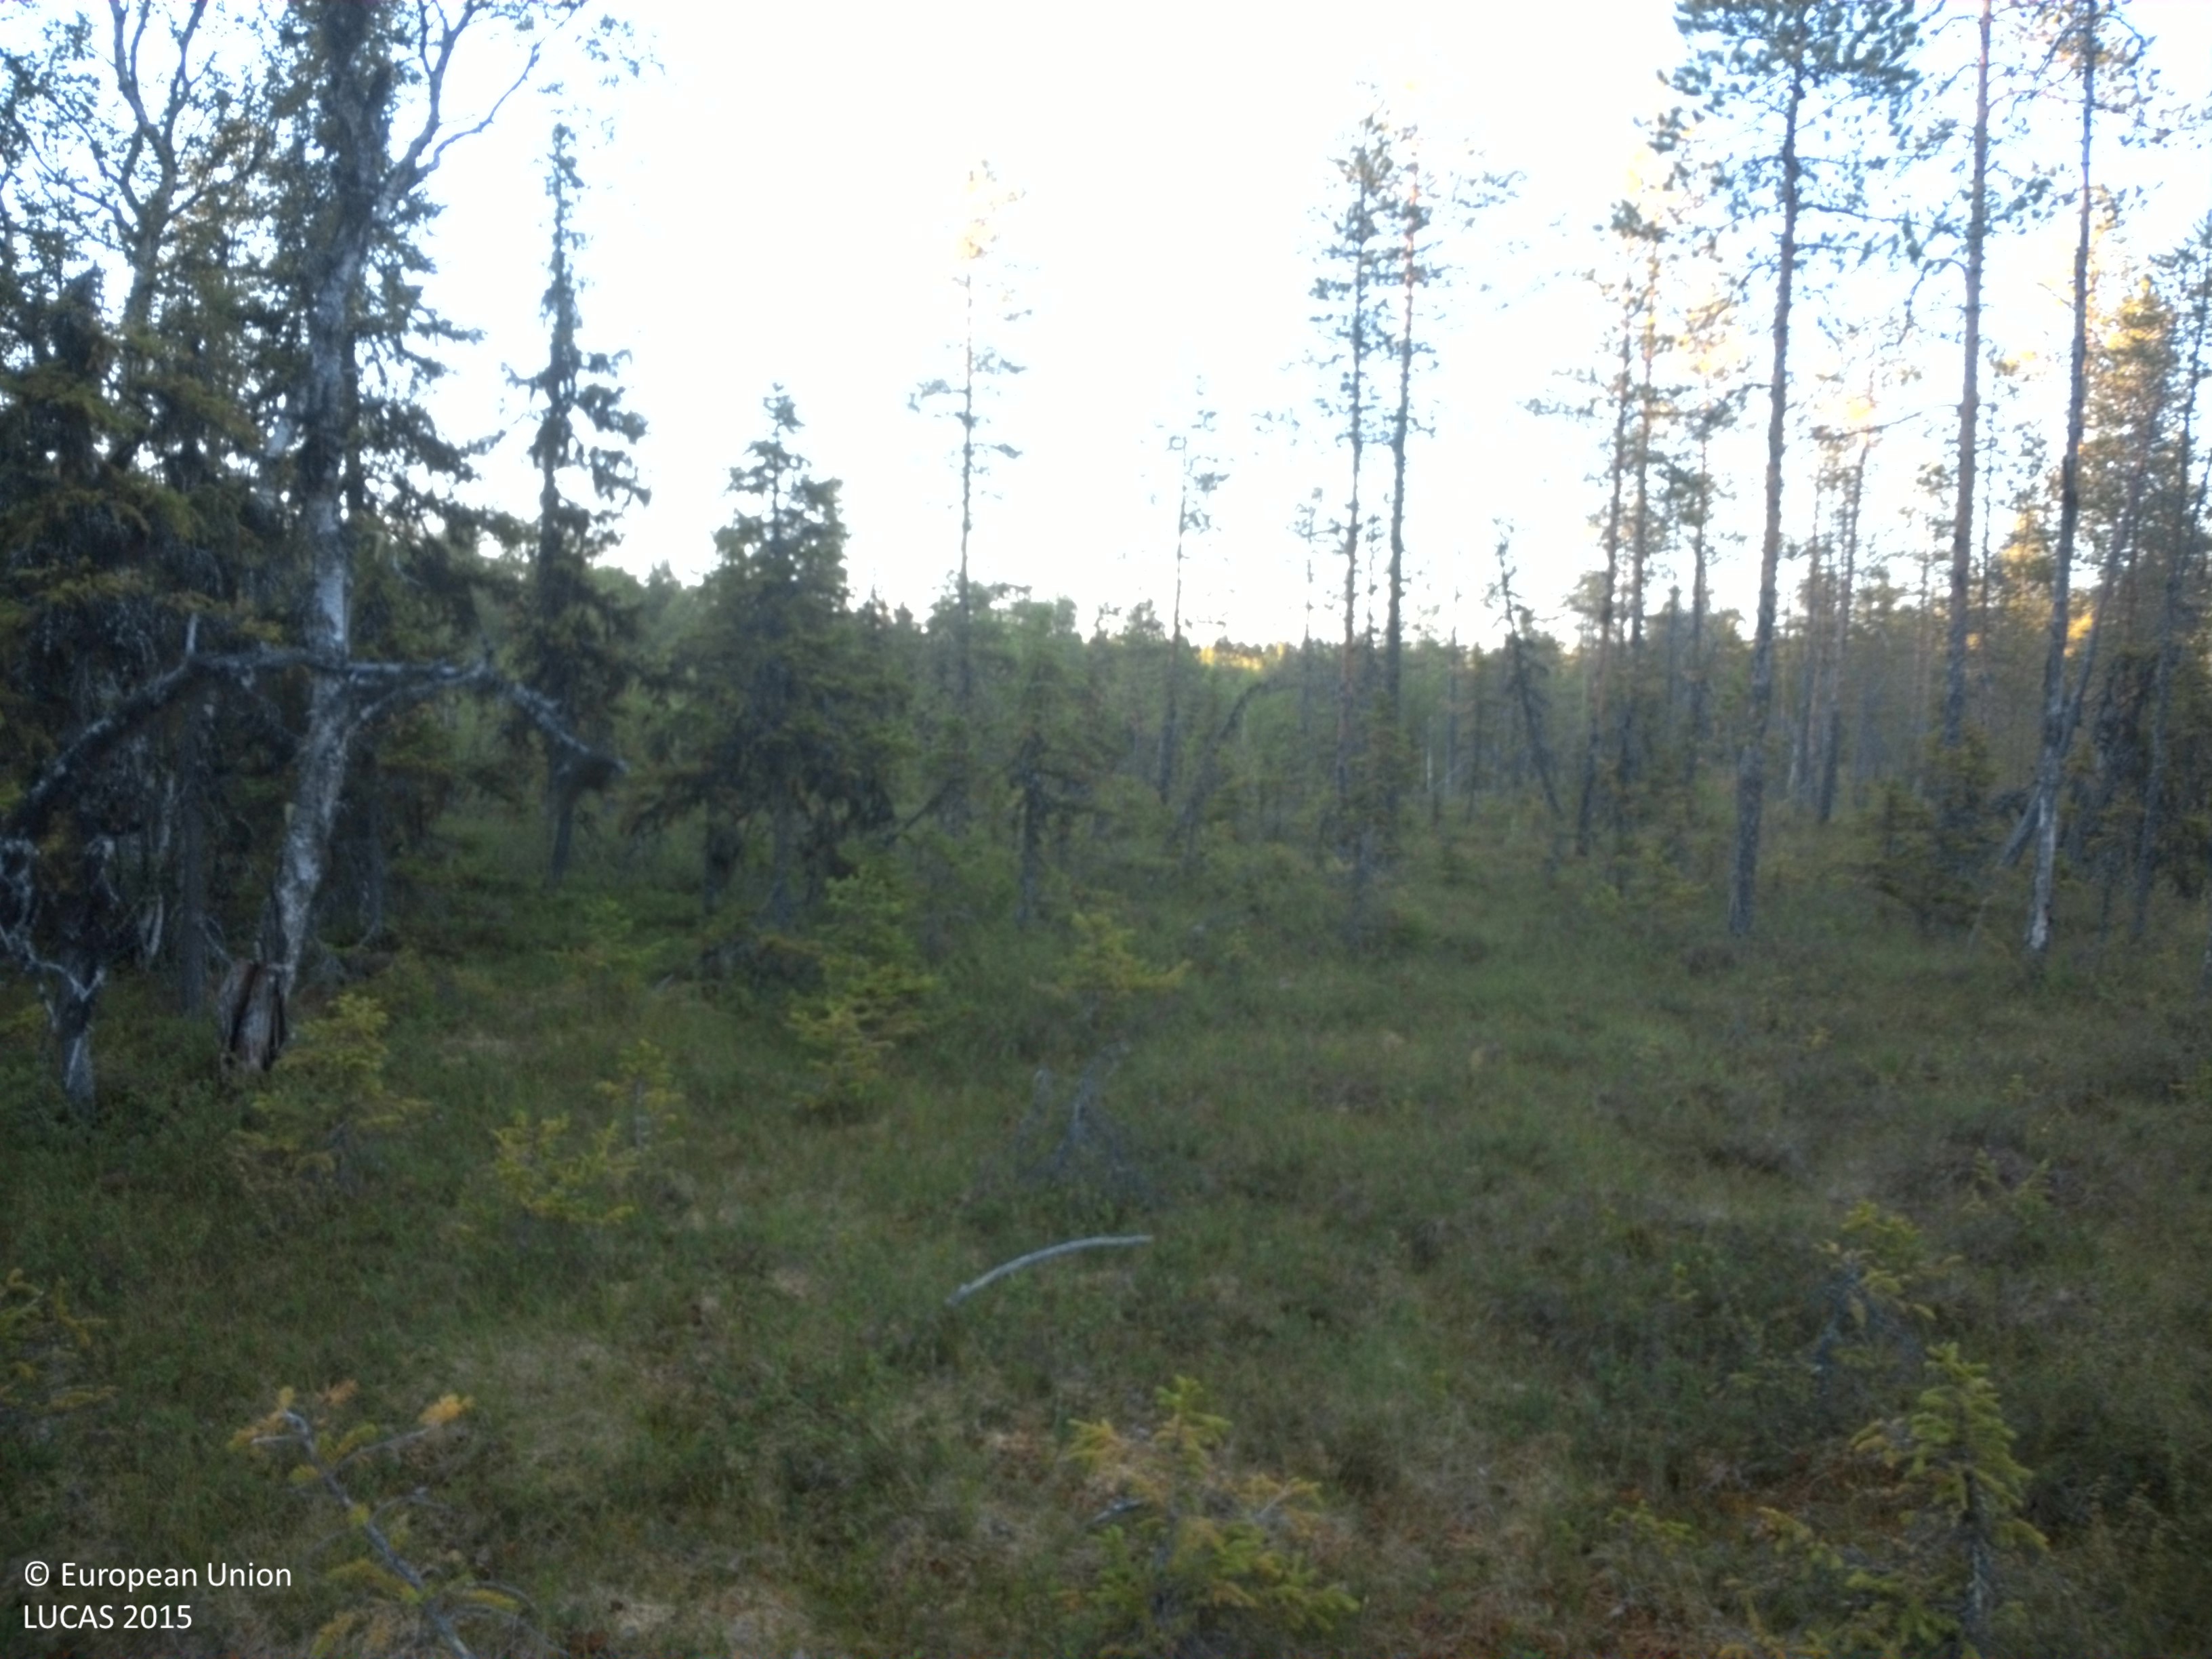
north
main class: Woodland
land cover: Pine dominated coniferous woodland
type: boreal forest
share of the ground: 25 - 50 %
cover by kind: coniferous forest trees 35 %, lichens and mosses 30 %, herbaceous plants 20 %, shrubs 15 %
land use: Forestry
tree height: > 5 m
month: August
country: SE
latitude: 64.4514
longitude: 18.6767
